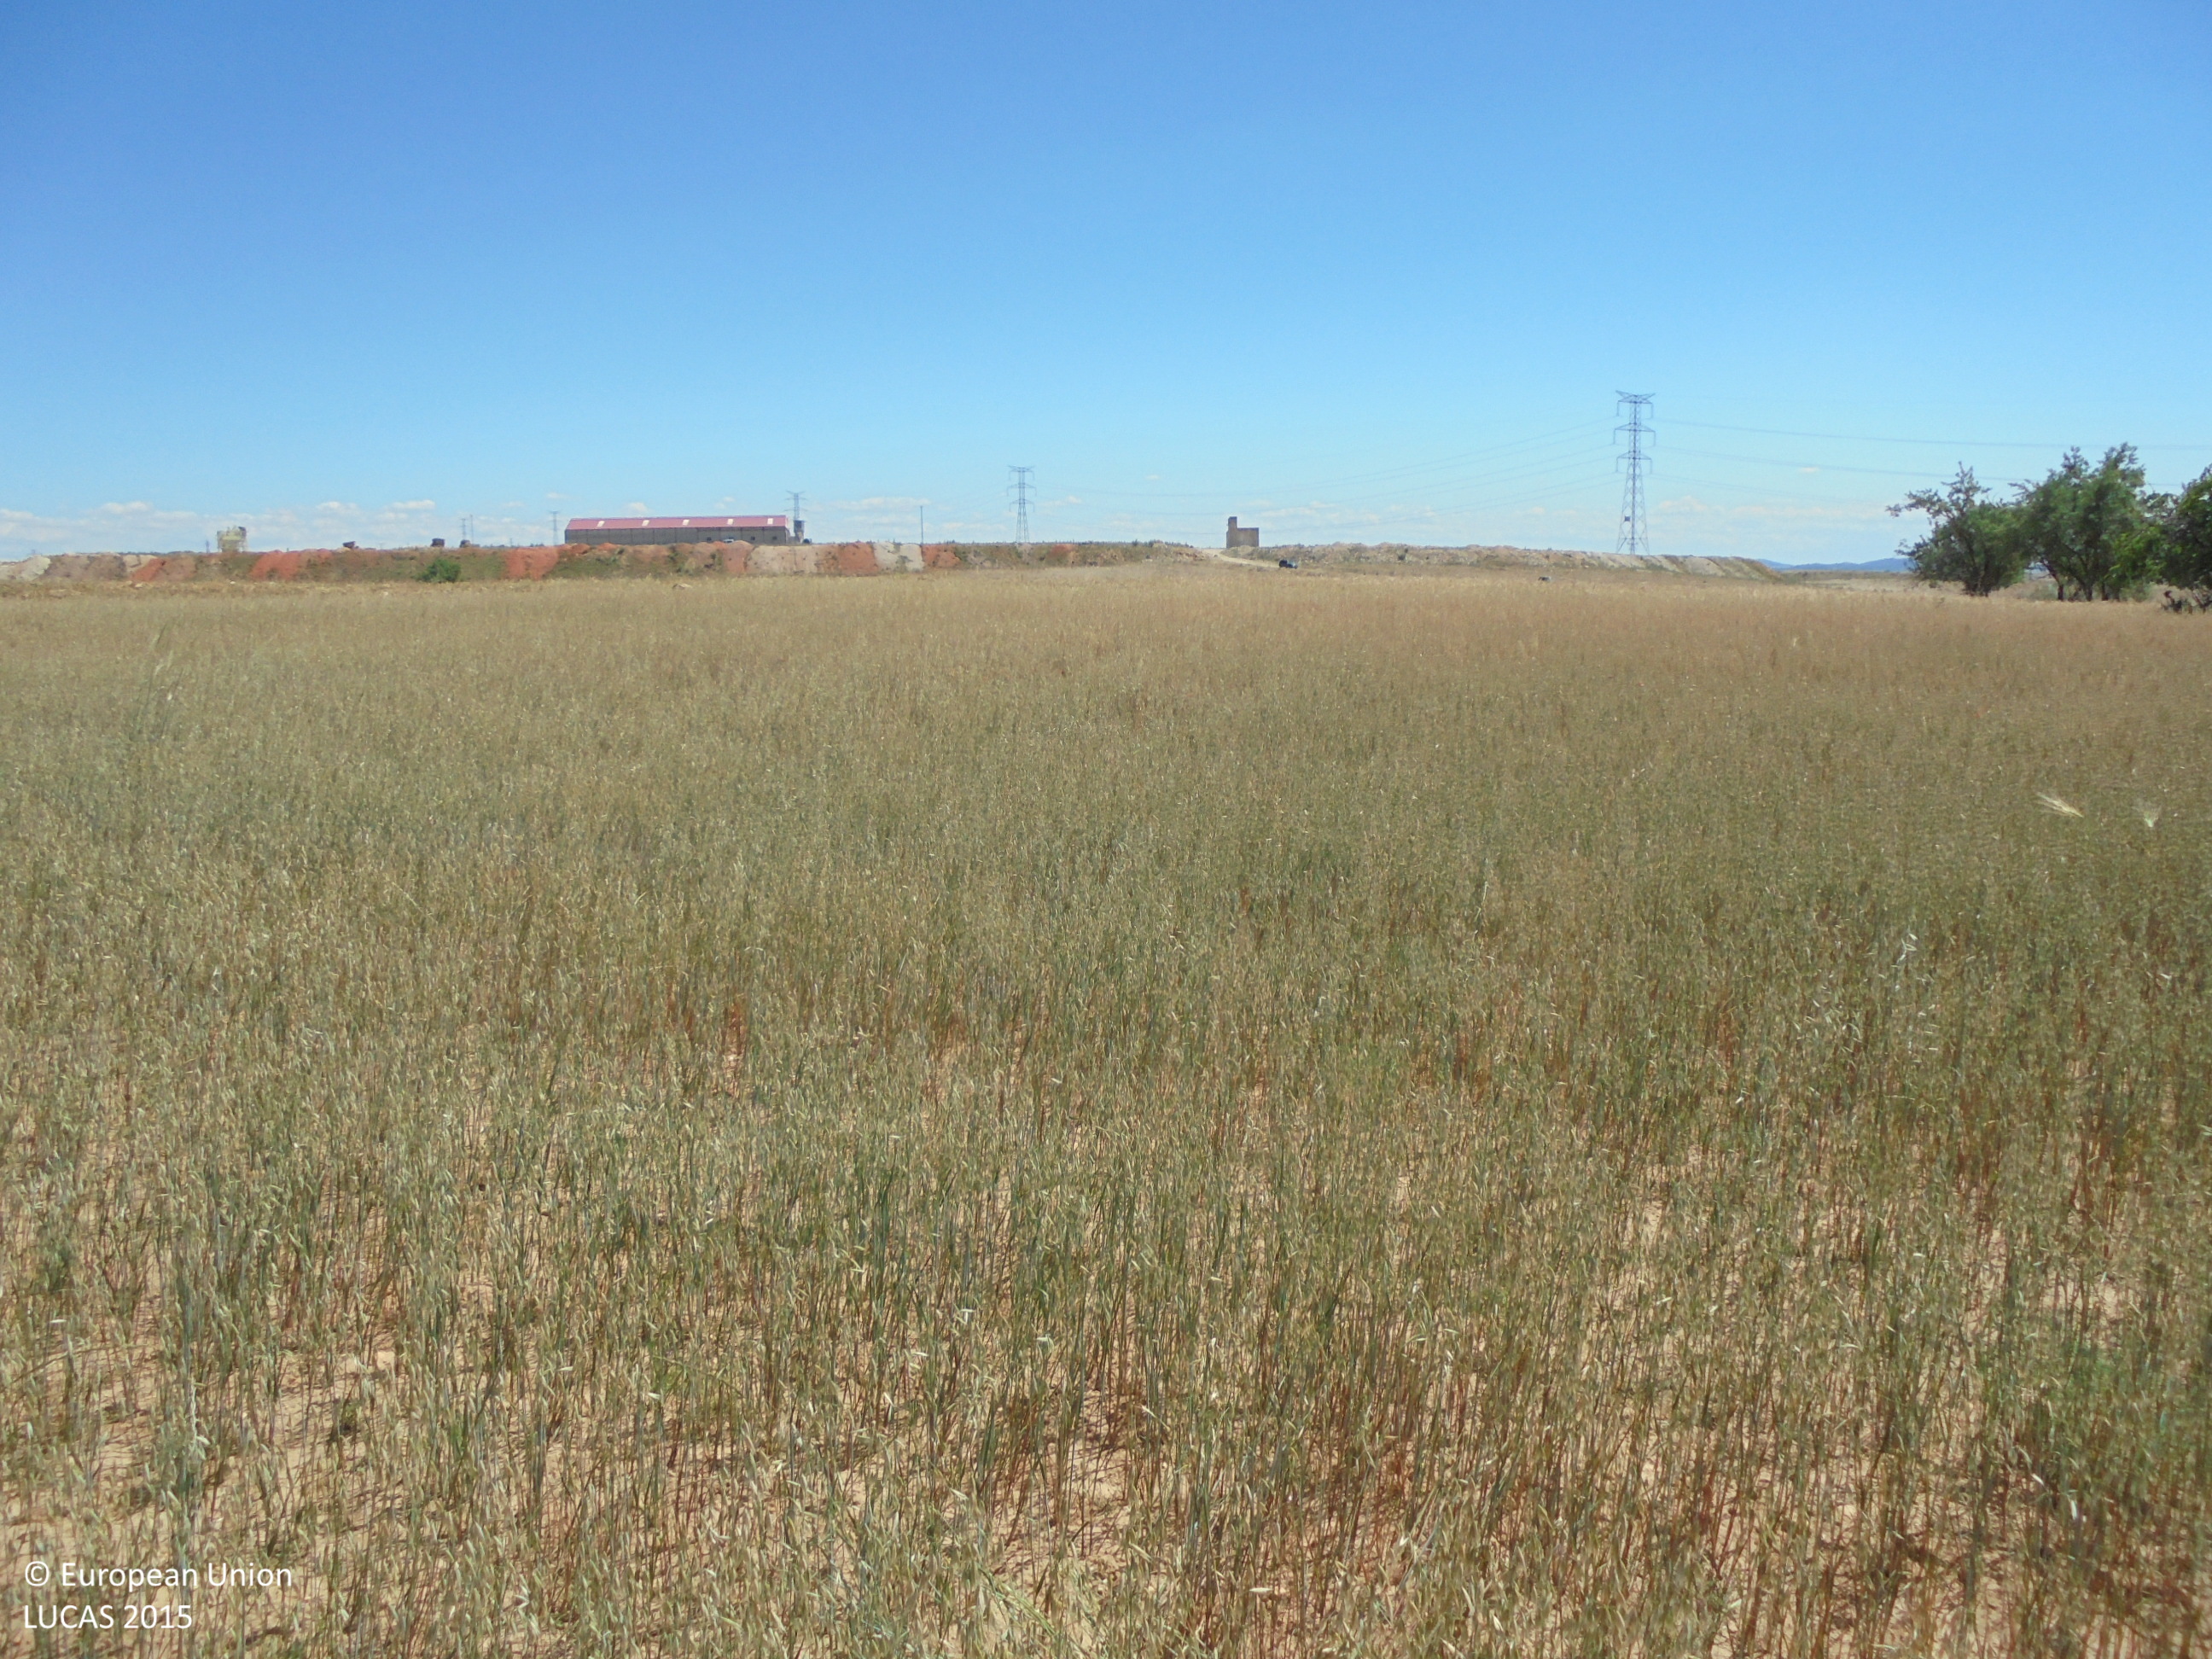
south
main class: Cropland
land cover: Oats
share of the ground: 25 - 50 %
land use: Agriculture (excluding fallow land and kitchen gardens)
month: May
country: ES
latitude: 38.9038
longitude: -1.7255
